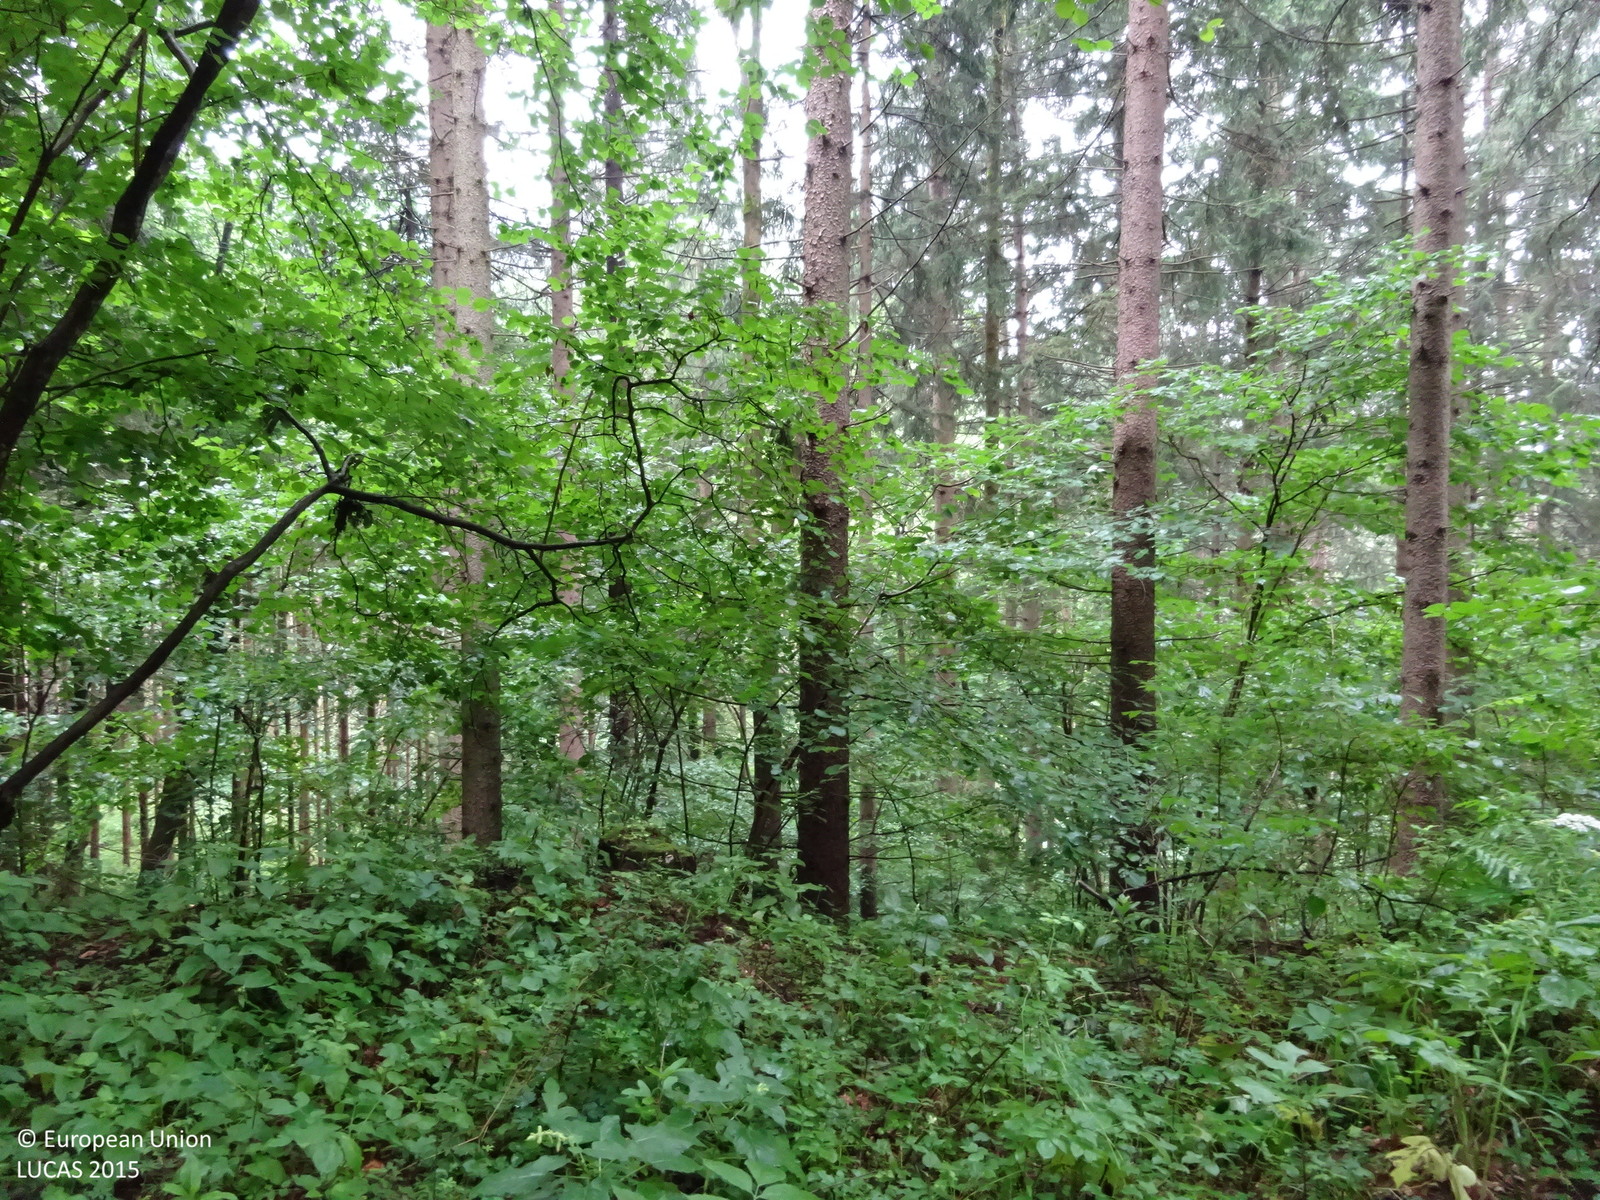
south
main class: Woodland
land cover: Spruce dominated mixed woodland
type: mountainous beech forest
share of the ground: > 75 %
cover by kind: coniferous forest trees 55 %, broadleaved forest trees 35 %, herbaceous plants 5 %, lichens and mosses 5 %
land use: Forestry
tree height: > 5 m
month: July
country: AT
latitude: 47.3164
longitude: 15.3846
